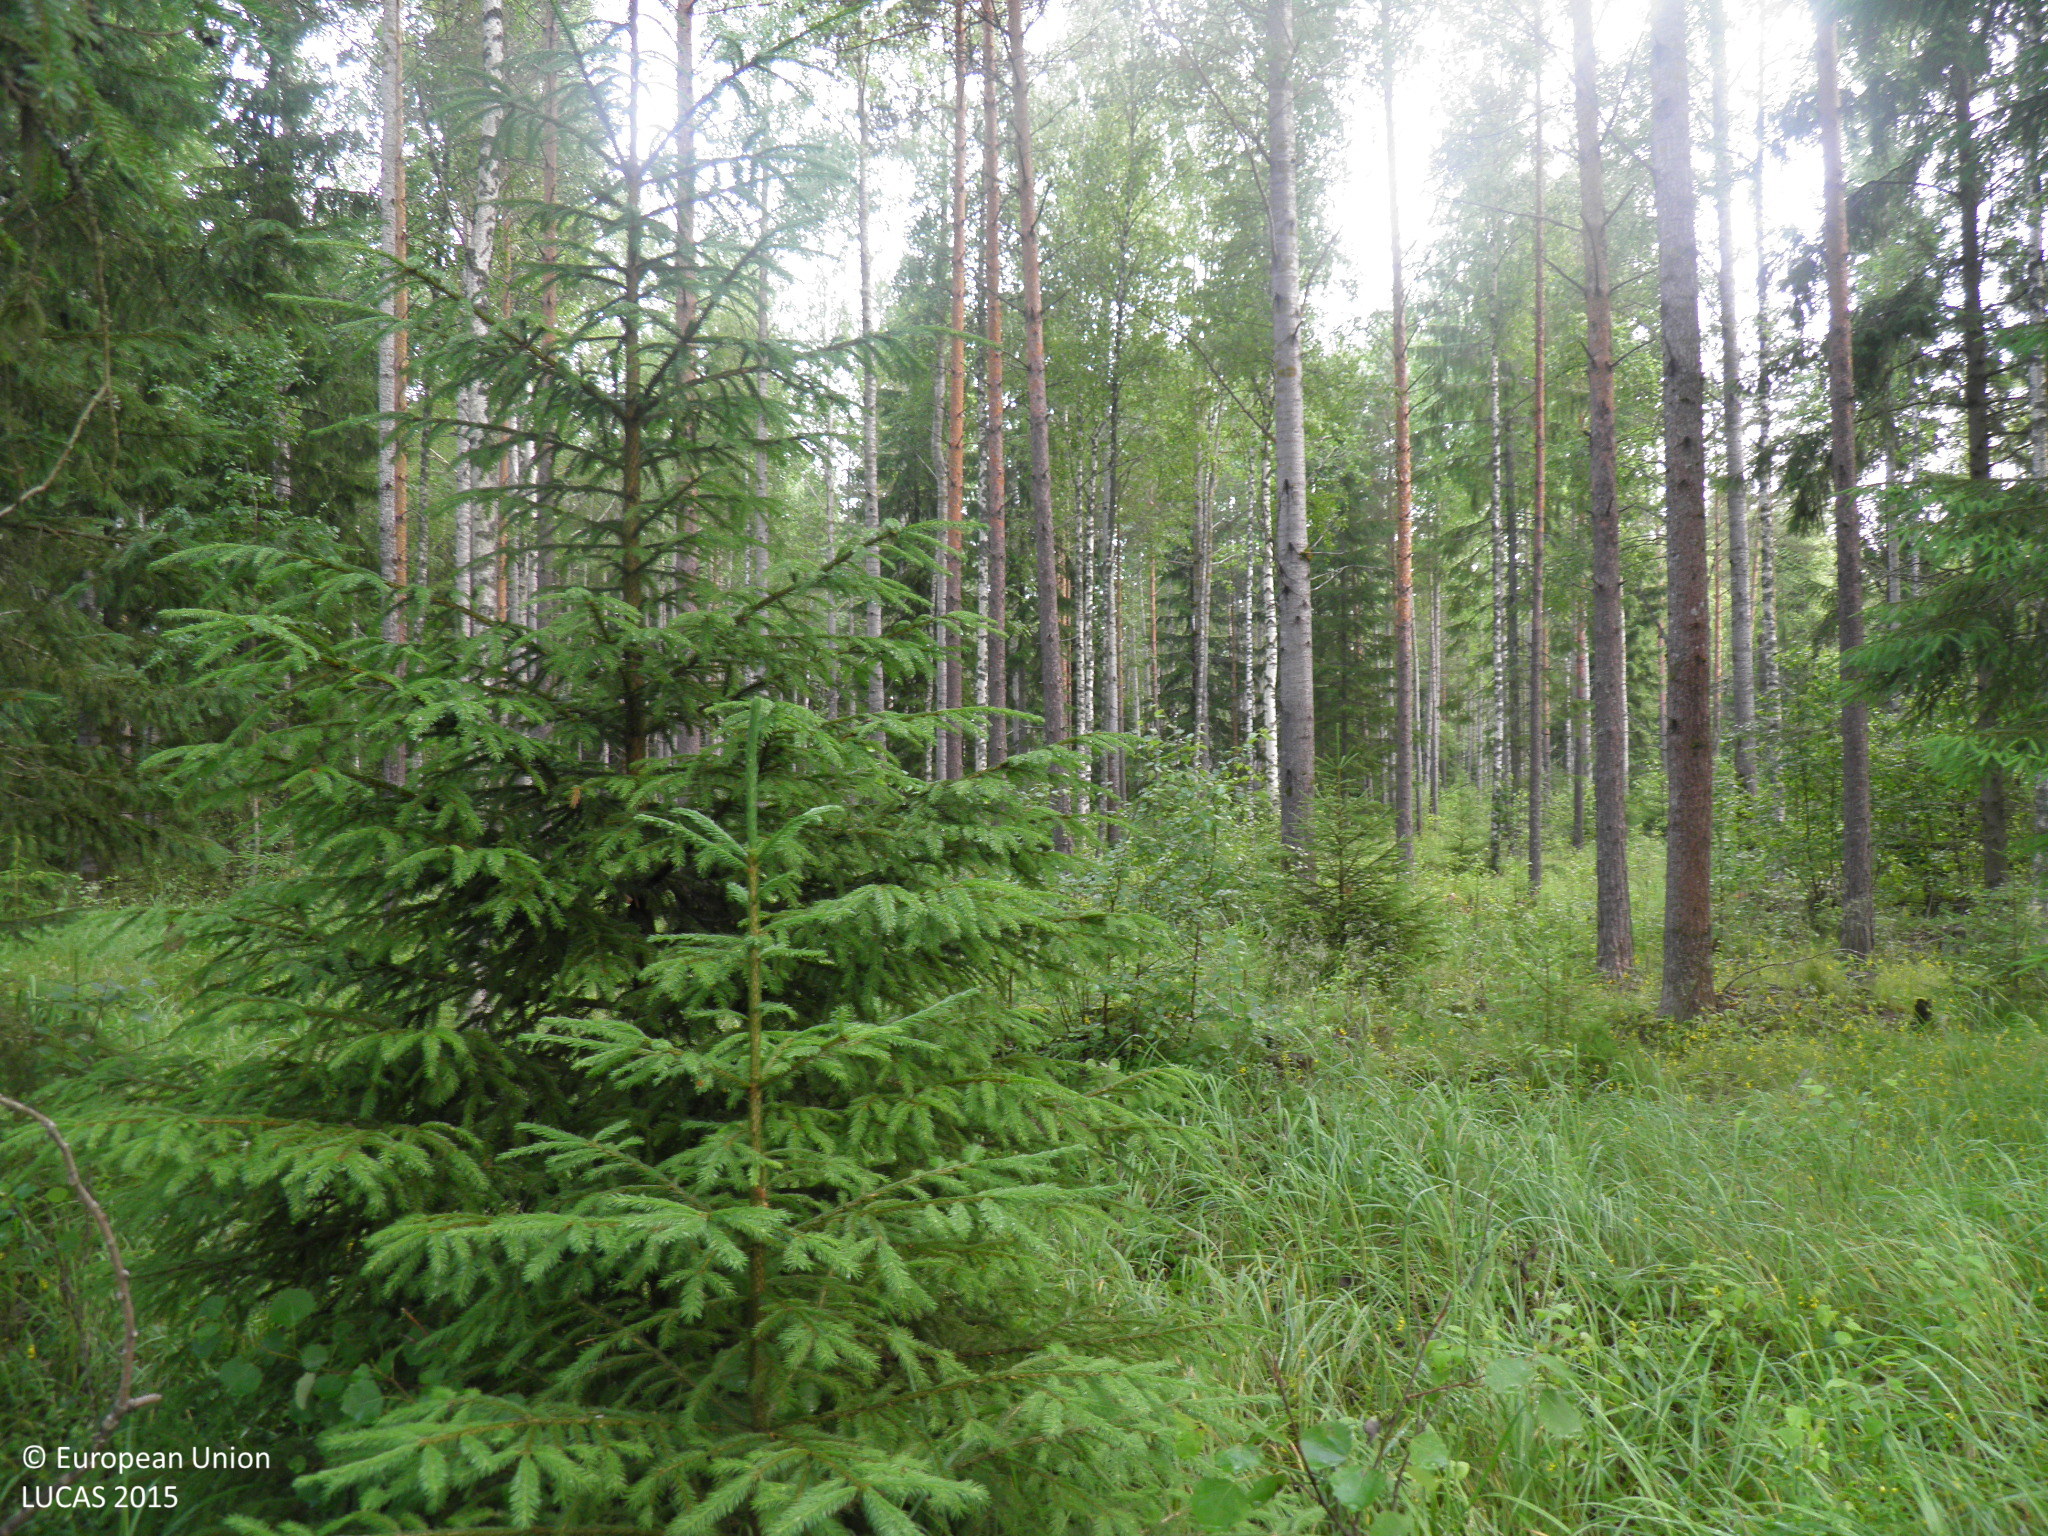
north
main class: Woodland
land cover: Other mixed woodland
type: hemiboreal forest and nemoral coniferous forest and mixed broadleaved-coniferous forest
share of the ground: 50 - 75 %
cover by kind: broadleaved forest trees 40 %, coniferous forest trees 20 %, shrubs 20 %, herbaceous plants 20 %
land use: Forestry
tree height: > 5 m
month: July
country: FI
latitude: 60.6699
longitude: 22.4214
